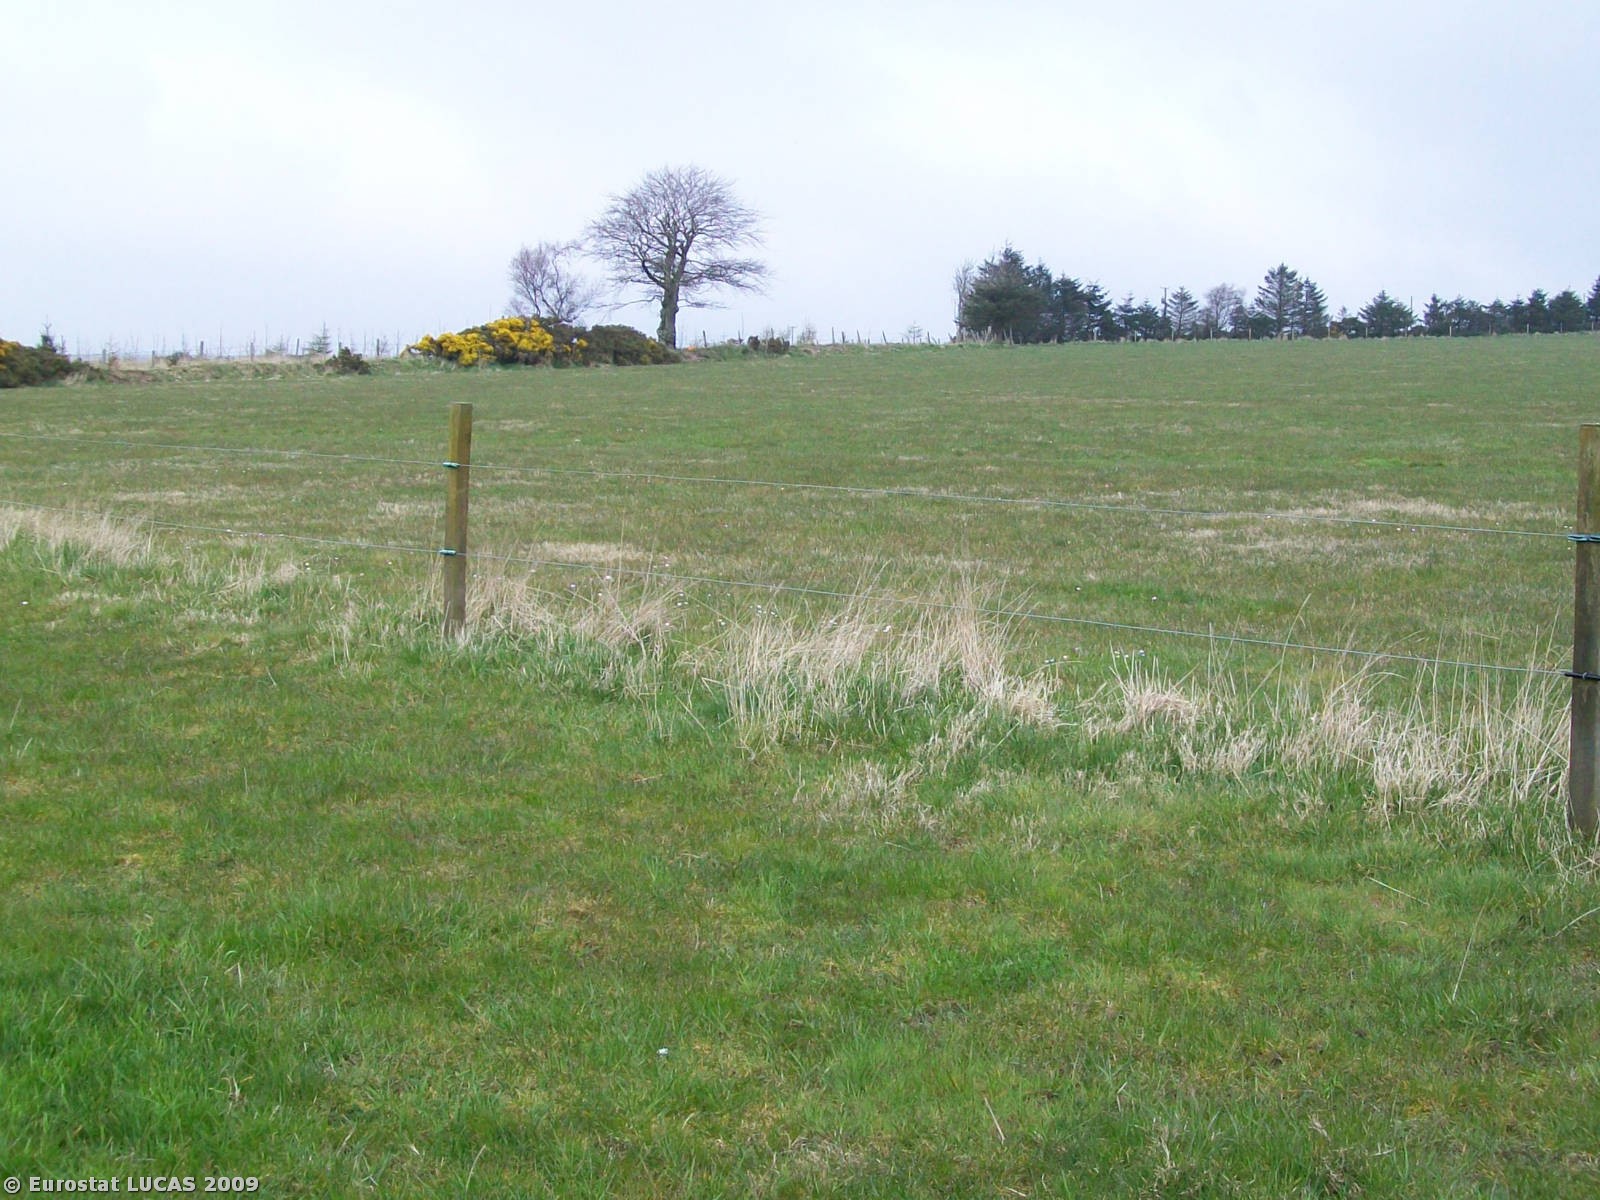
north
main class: Grassland
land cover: Grassland without tree/shrub cover
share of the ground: > 75 %
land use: Agriculture (excluding fallow land and kitchen gardens)
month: April
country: GB
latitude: 56.9321
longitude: -2.3947
